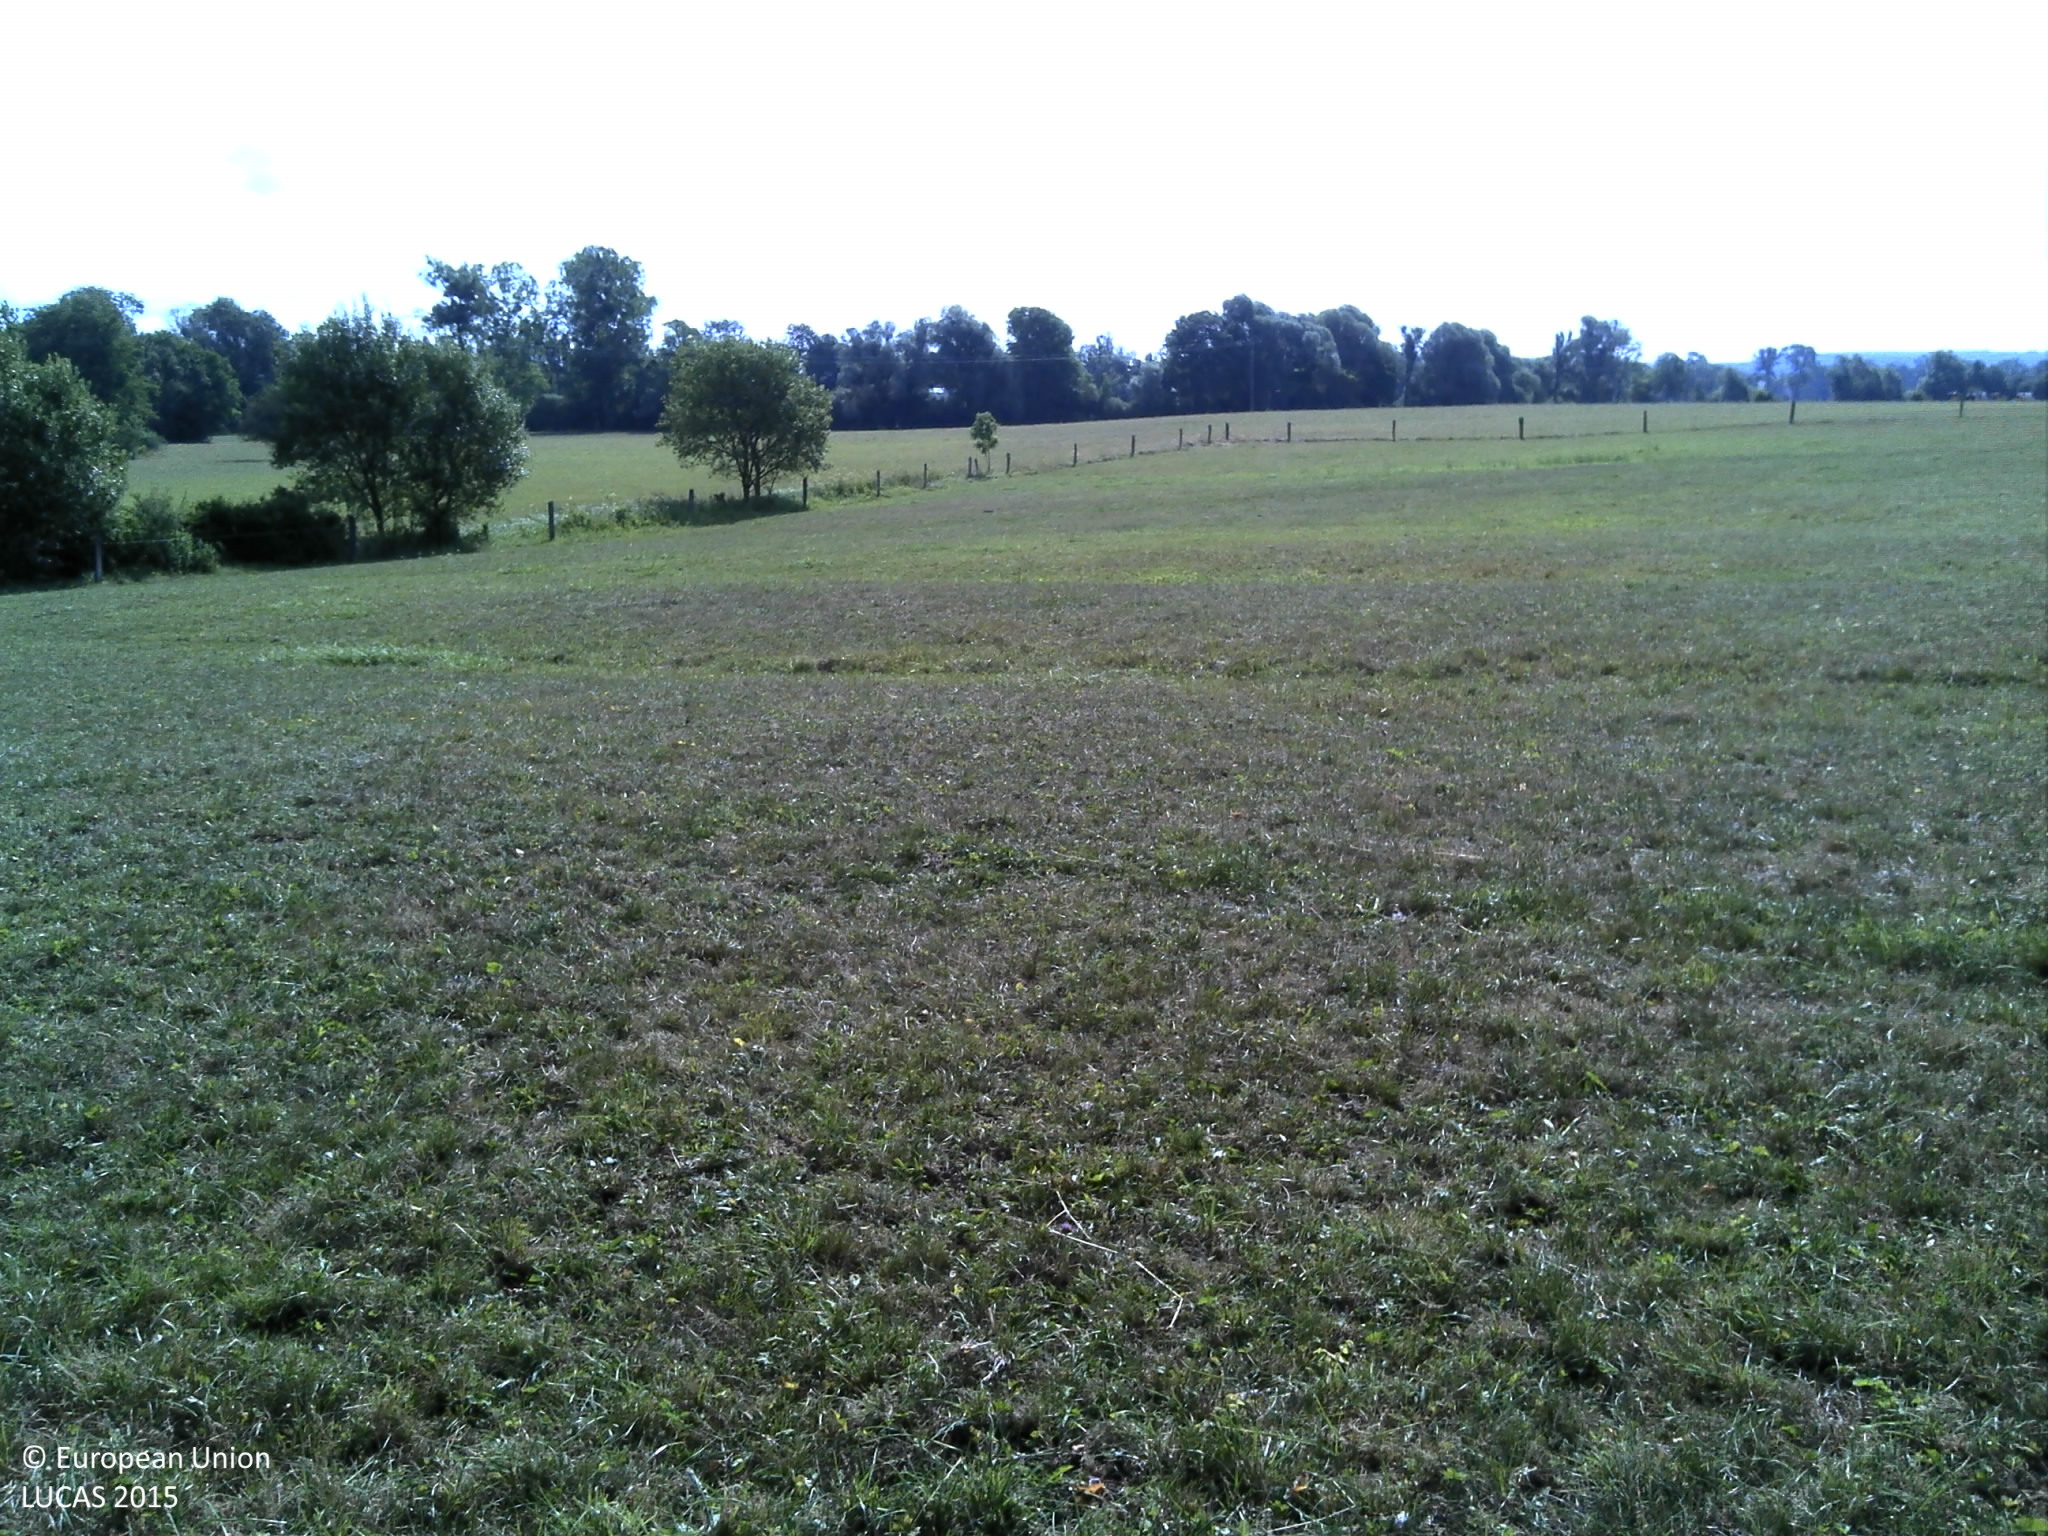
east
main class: Grassland
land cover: Grassland with sparse tree/shrub cover
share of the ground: > 75 %
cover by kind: herbaceous plants 95 %, broadleaved forest trees 5 %
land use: Agriculture (excluding fallow land and kitchen gardens)
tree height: > 5 m
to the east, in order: Grassland with sparse tree/shrub cover; Grassland without tree/shrub cover; Fences; Grassland with sparse tree/shrub cover; Grassland without tree/shrub cover; Electric lines; Grassland without tree/shrub cover
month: July
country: FR
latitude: 48.2137
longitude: 6.2457
